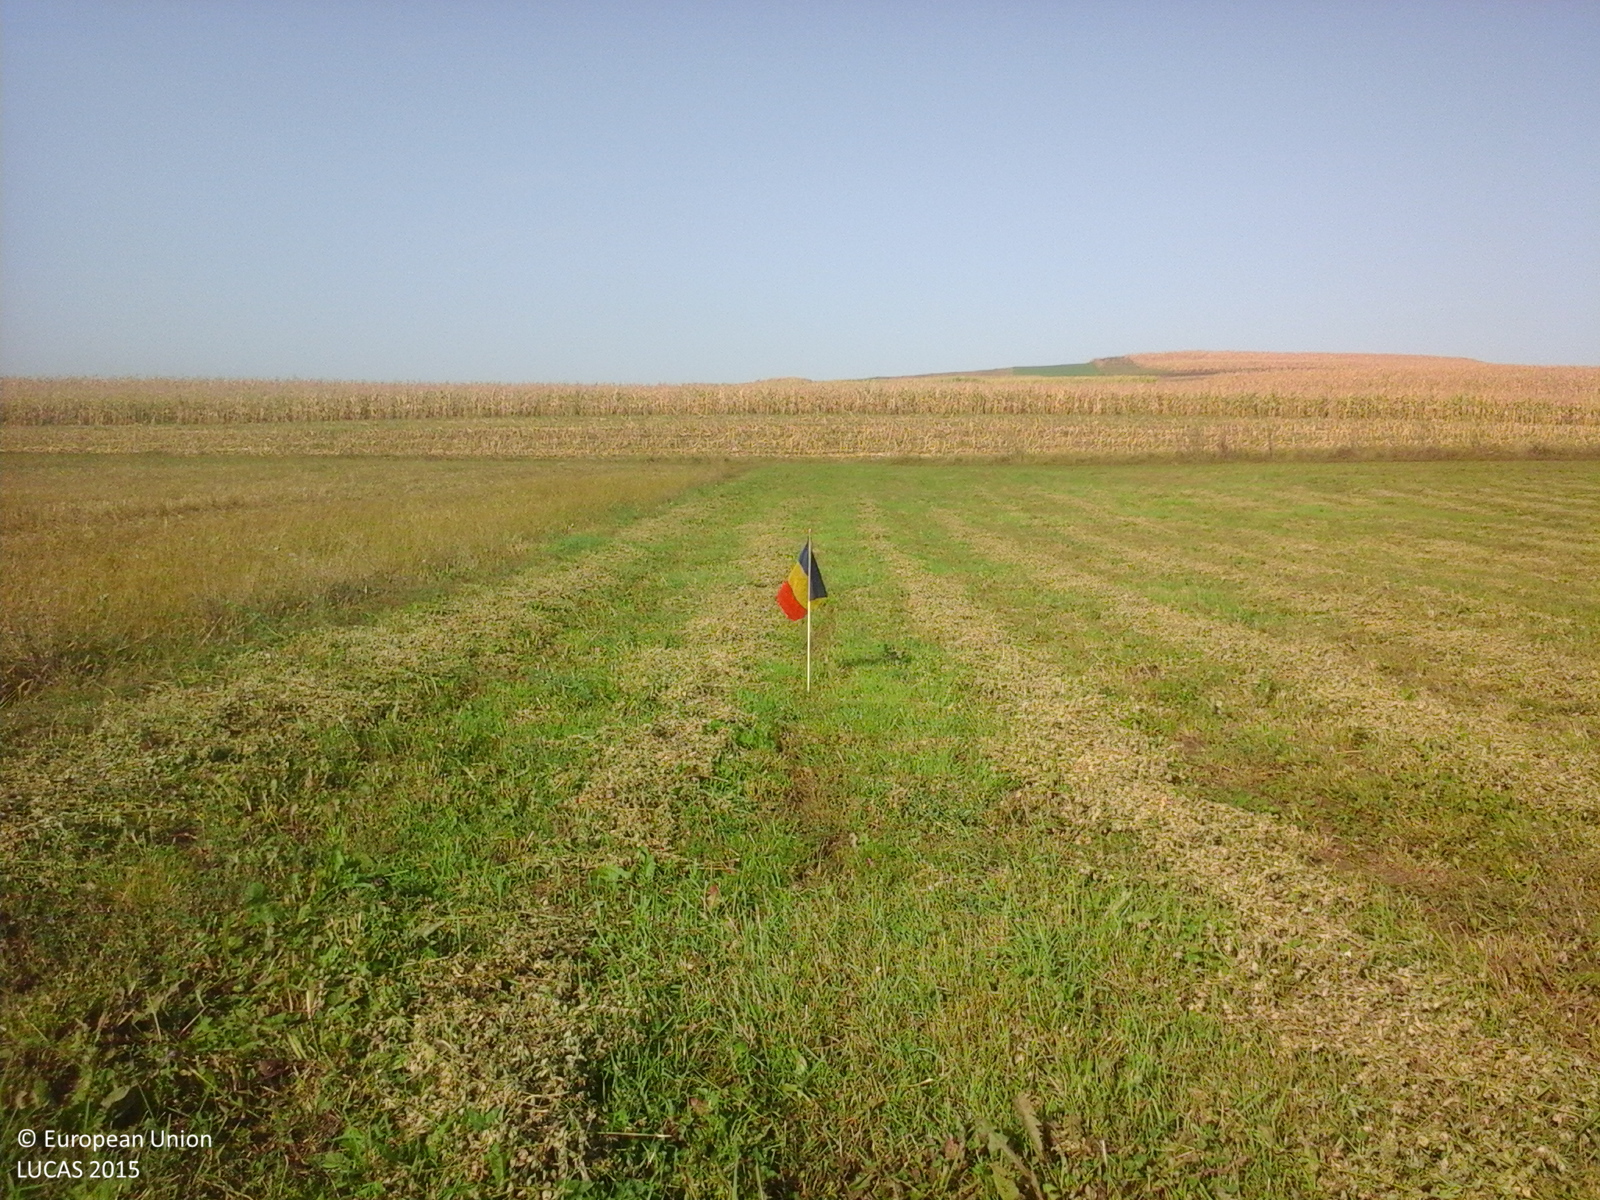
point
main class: Cropland
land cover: Lucerne
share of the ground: > 75 %
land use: Agriculture (excluding fallow land and kitchen gardens)
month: September
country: RO
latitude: 46.7027
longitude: 24.0074
